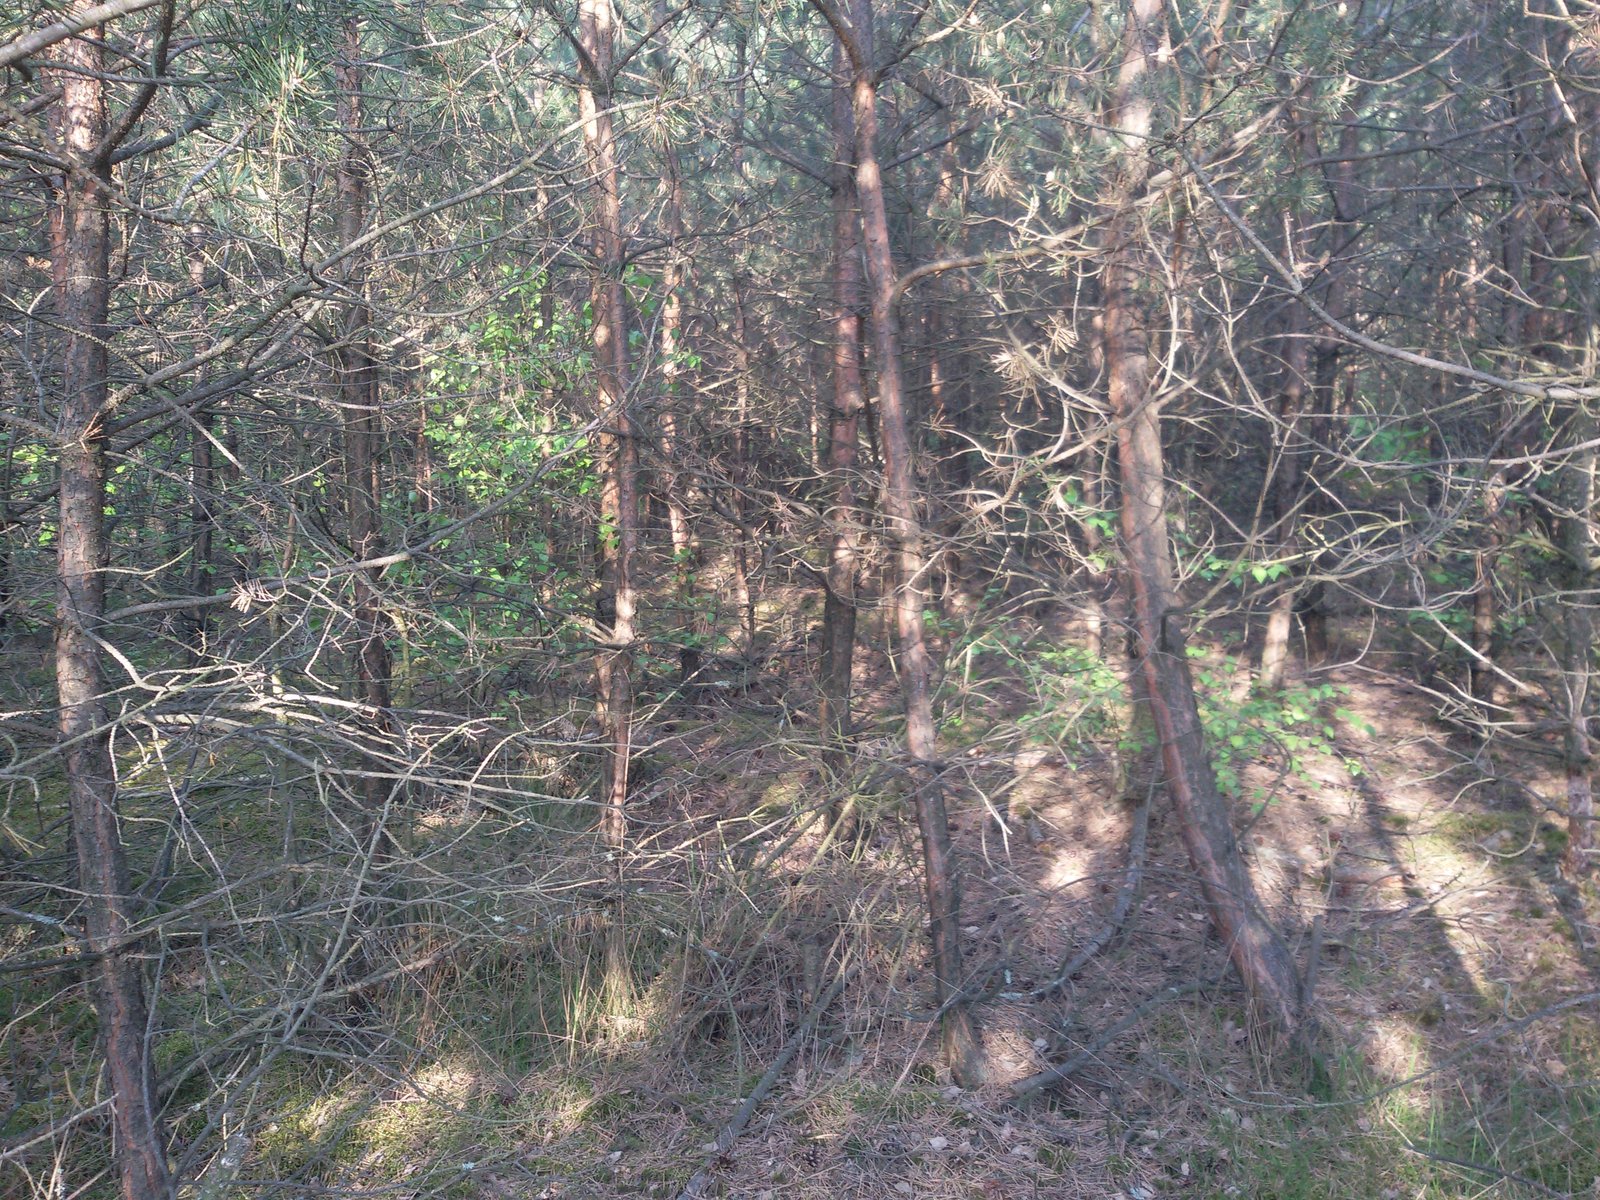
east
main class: Woodland
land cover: Pine dominated mixed woodland
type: hemiboreal forest and nemoral coniferous forest and mixed broadleaved-coniferous forest
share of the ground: > 75 %
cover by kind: coniferous forest trees 60 %, broadleaved forest trees 20 %, herbaceous plants 10 %, unconsolidated bare surface 10 %
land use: Forestry
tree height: > 5 m
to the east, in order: Pine dominated mixed woodland; Pine dominated coniferous woodland
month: May
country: PL
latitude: 52.2628
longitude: 16.9694
